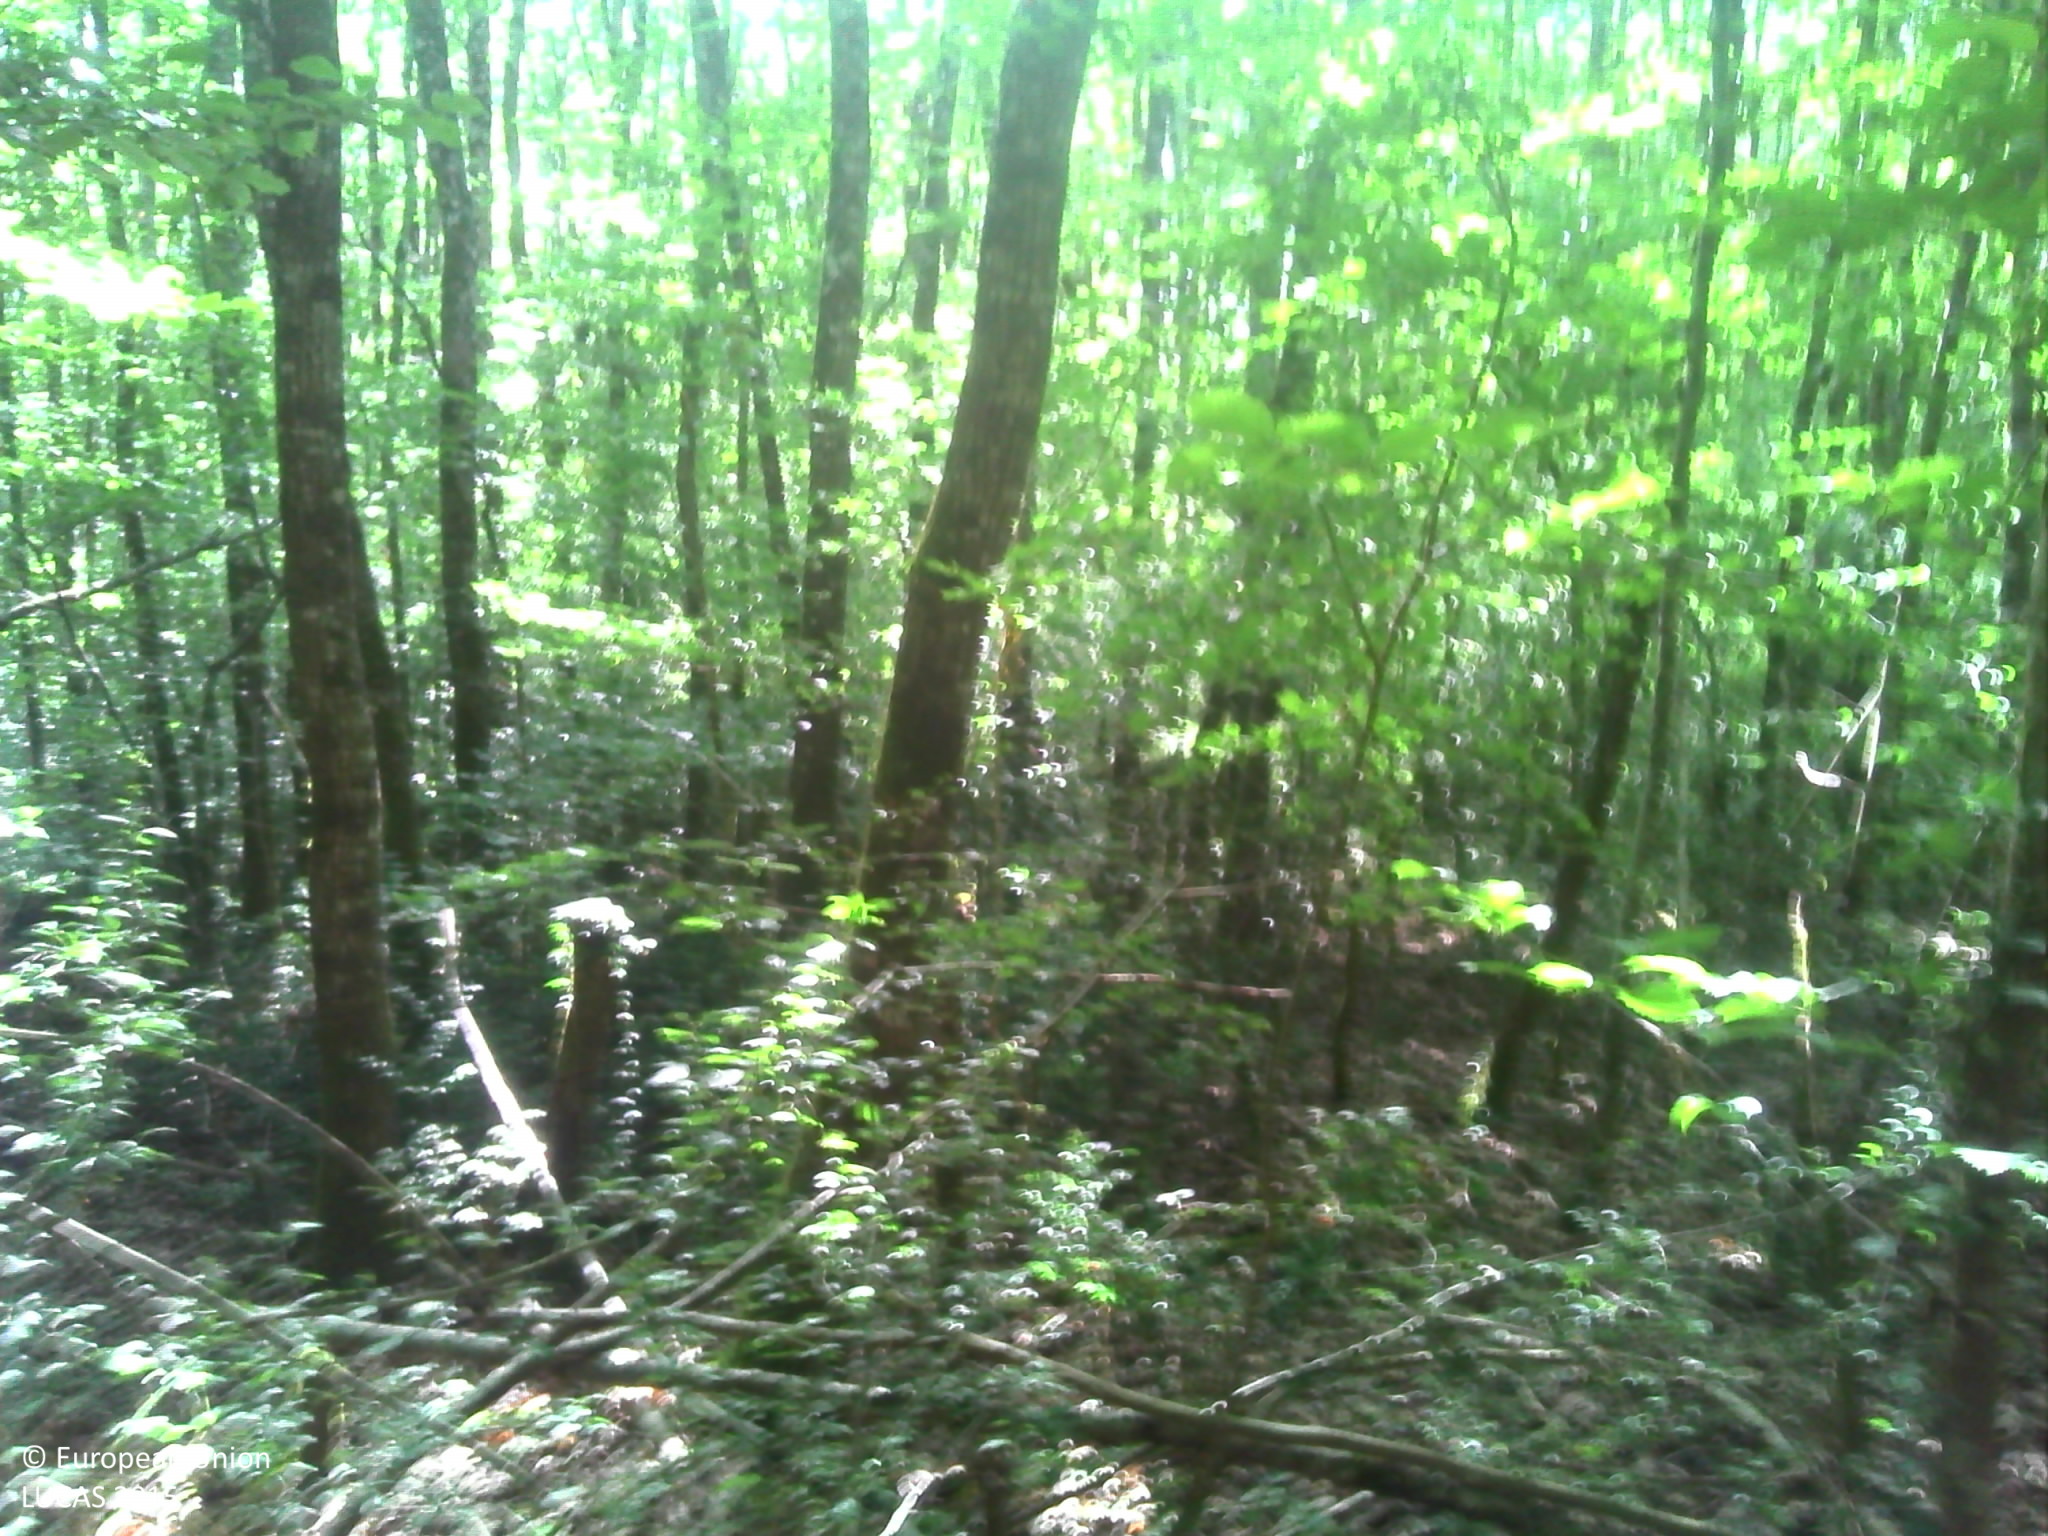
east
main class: Woodland
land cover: Broadleaved woodland
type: mesophytic deciduous forest
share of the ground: > 75 %
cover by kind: unconsolidated bare surface 50 %, herbaceous plants 30 %, broadleaved forest trees 20 %
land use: Forestry
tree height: > 5 m
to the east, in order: Broadleaved woodland; Tracks; Ditches and canals; Broadleaved woodland; Tracks; Spruce dominated coniferous woodland
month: June
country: FR
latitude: 47.5224
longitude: 1.3659
